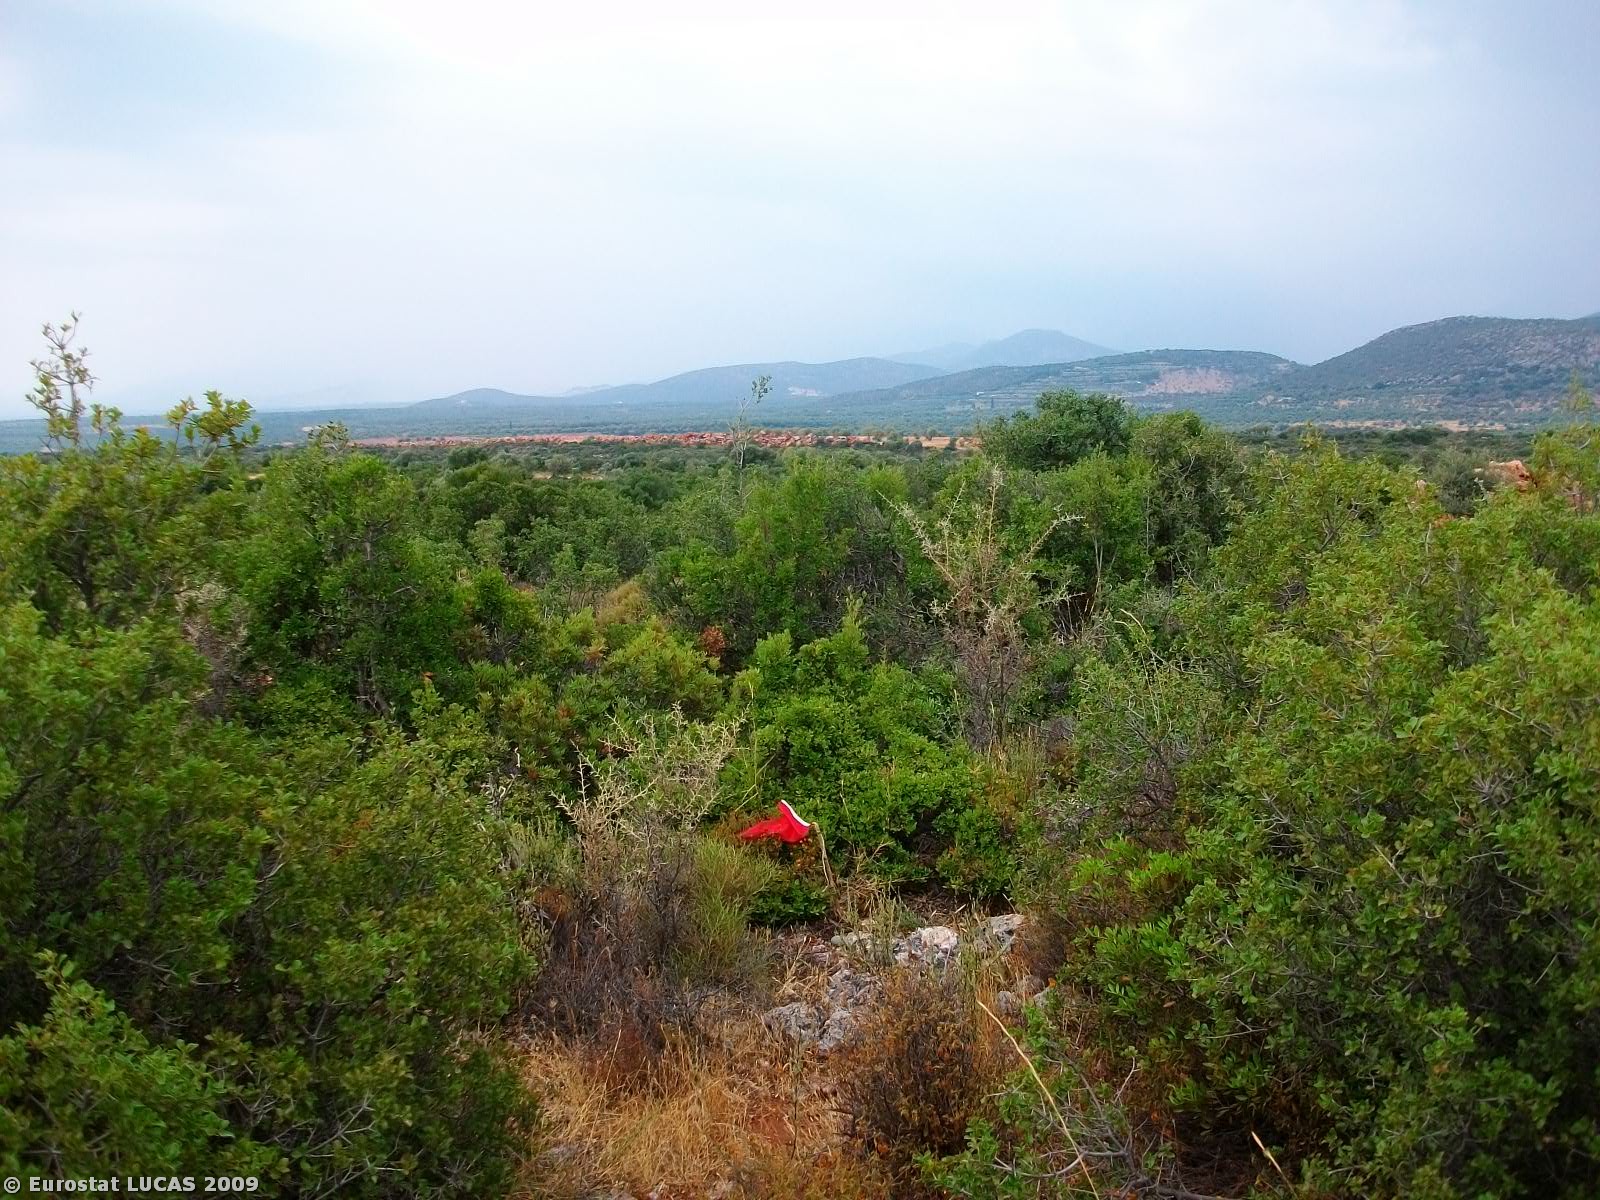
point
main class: Shrubland
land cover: Shrubland without tree cover
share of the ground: > 75 %
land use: Unused
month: August
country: GR
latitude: 36.9412
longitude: 22.7452
